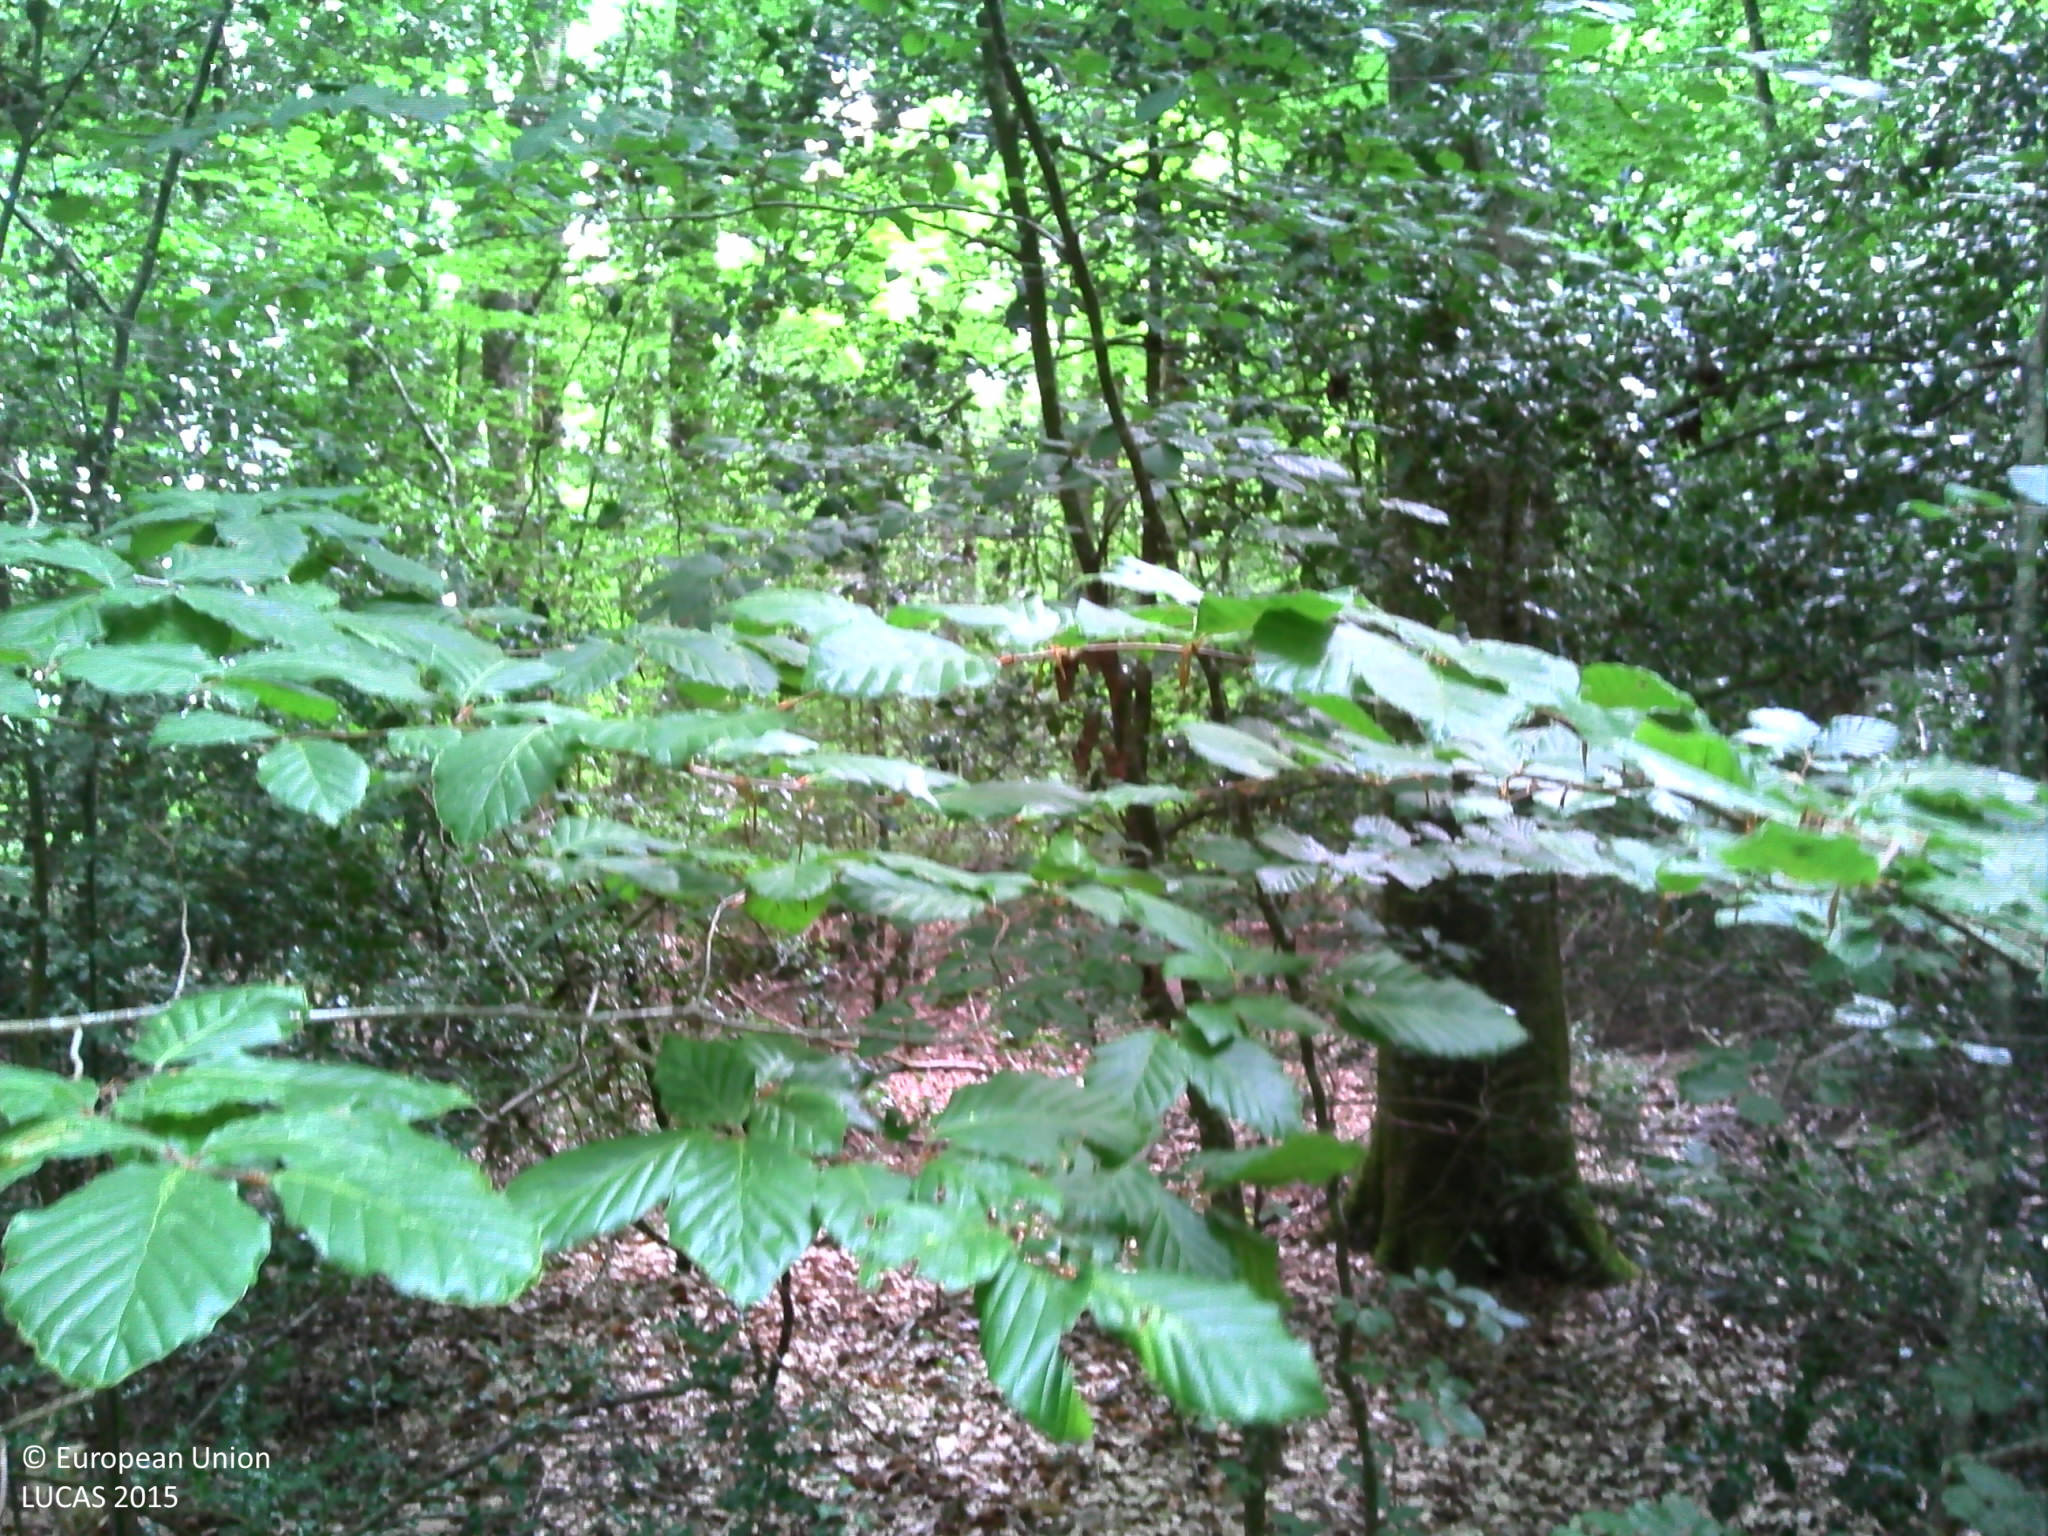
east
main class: Woodland
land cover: Broadleaved woodland
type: acidophilous oak and oak-birch forest
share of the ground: > 75 %
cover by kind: broadleaved forest trees 65 %, herbaceous plants 25 %, shrubs 10 %
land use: Forestry
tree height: > 5 m
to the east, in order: Broadleaved woodland
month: July
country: FR
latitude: 47.8241
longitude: 0.4261
